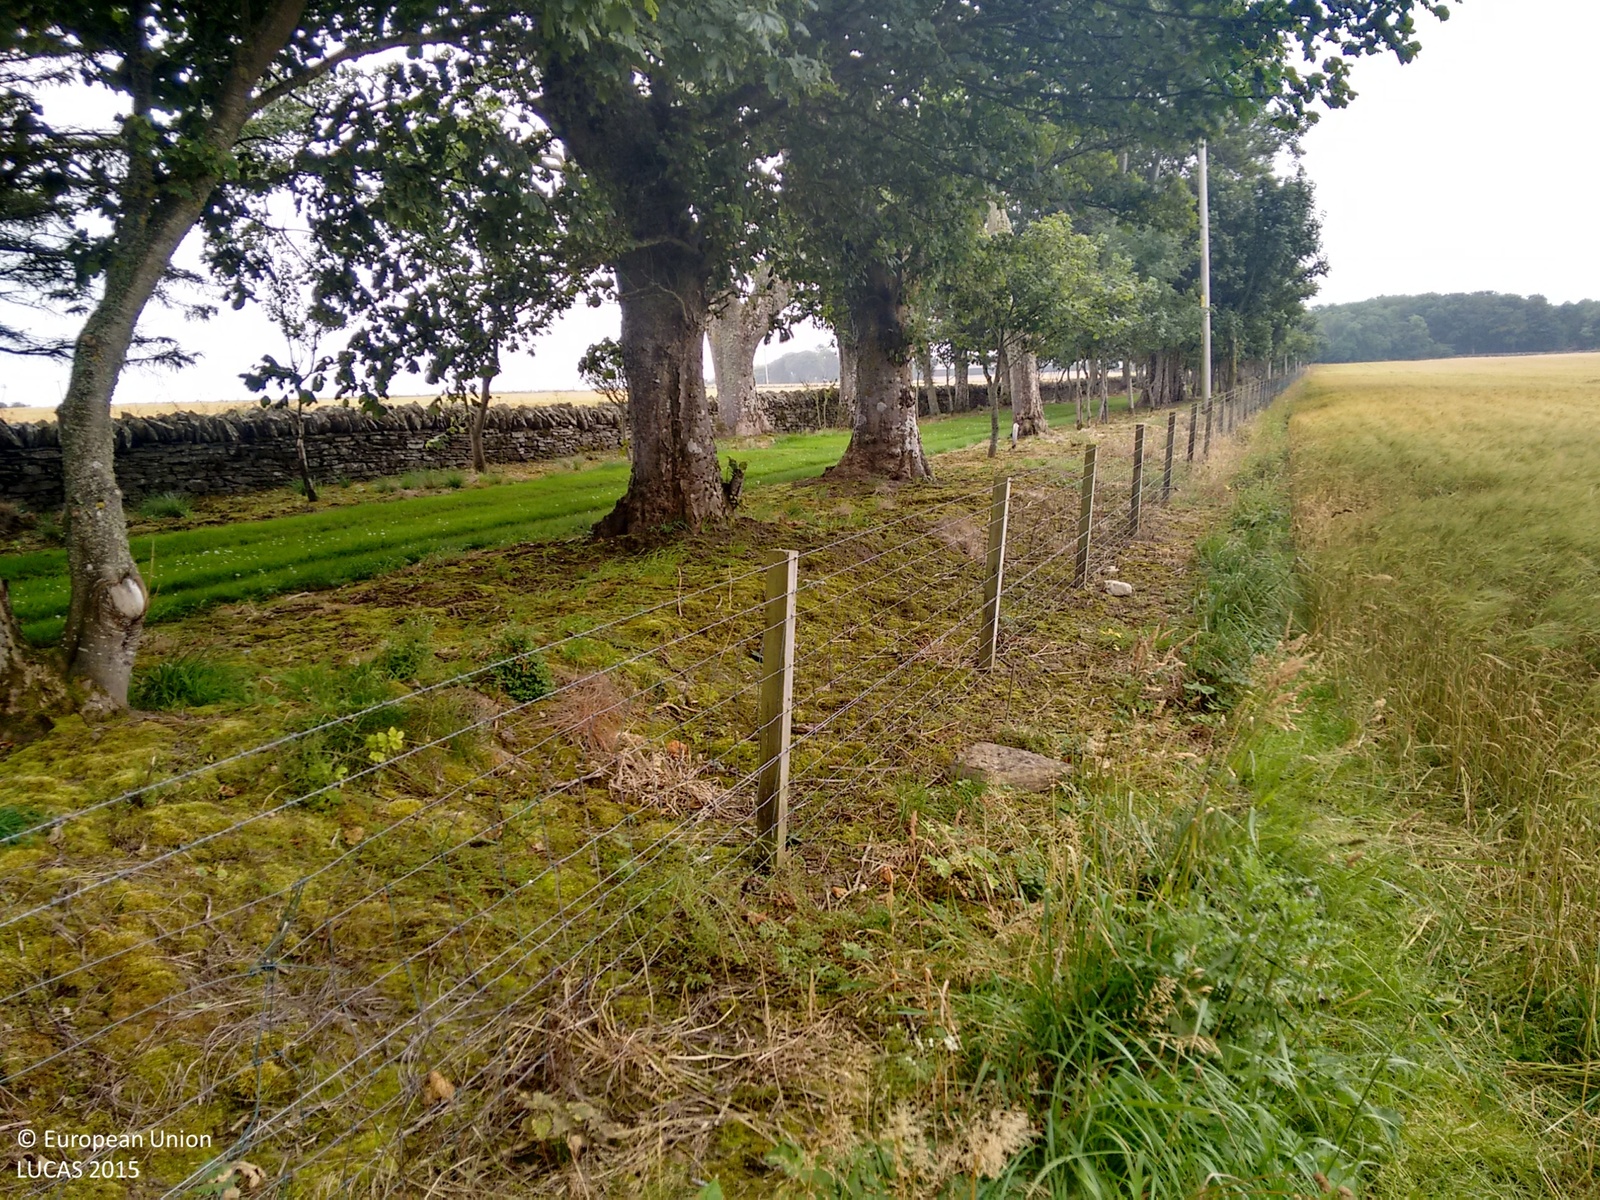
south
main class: Cropland
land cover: Common wheat
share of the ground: > 75 %
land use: Agriculture (excluding fallow land and kitchen gardens)
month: August
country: GB
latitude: 58.4450
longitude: -3.1651
